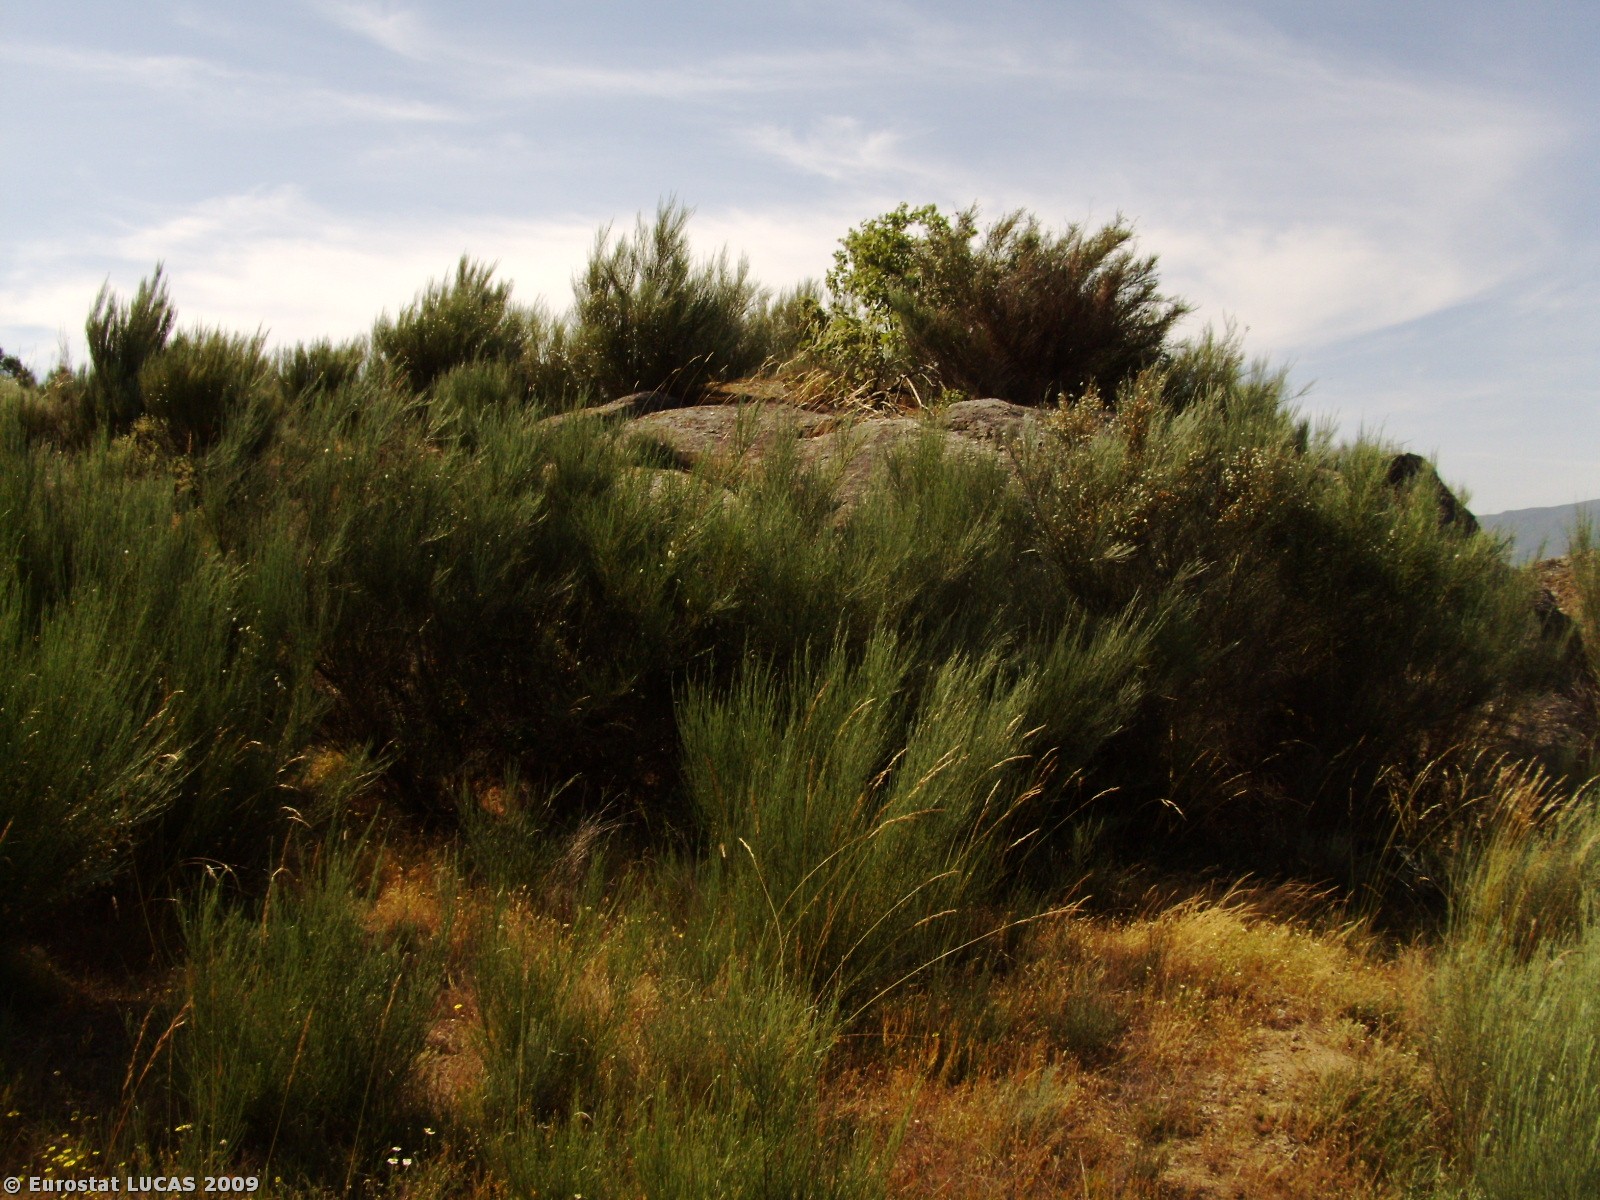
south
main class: Shrubland
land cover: Shrubland without tree cover
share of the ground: > 75 %
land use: Unused
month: June
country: PT
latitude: 40.5873
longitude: -7.4680
